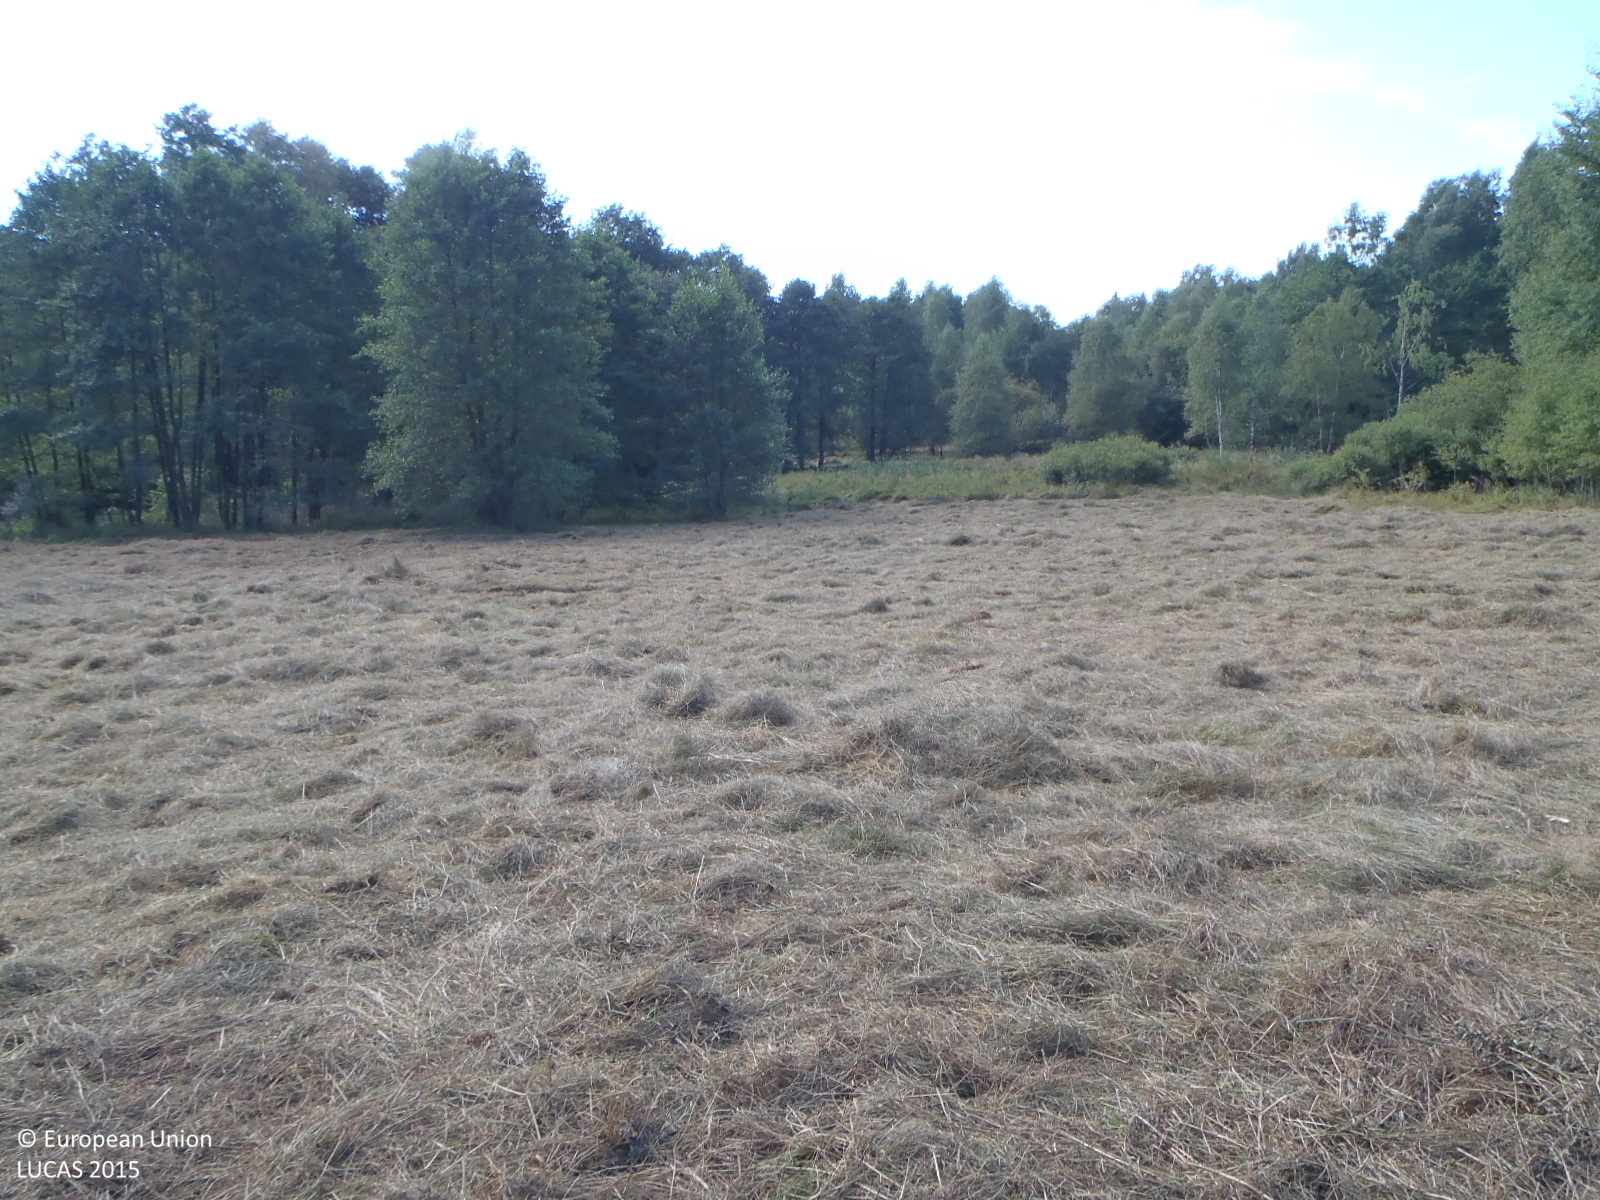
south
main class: Grassland
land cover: Grassland without tree/shrub cover
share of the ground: > 75 %
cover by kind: herbaceous plants 100 %
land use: Agriculture (excluding fallow land and kitchen gardens)
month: August
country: CZ
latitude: 50.8875
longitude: 14.5081
